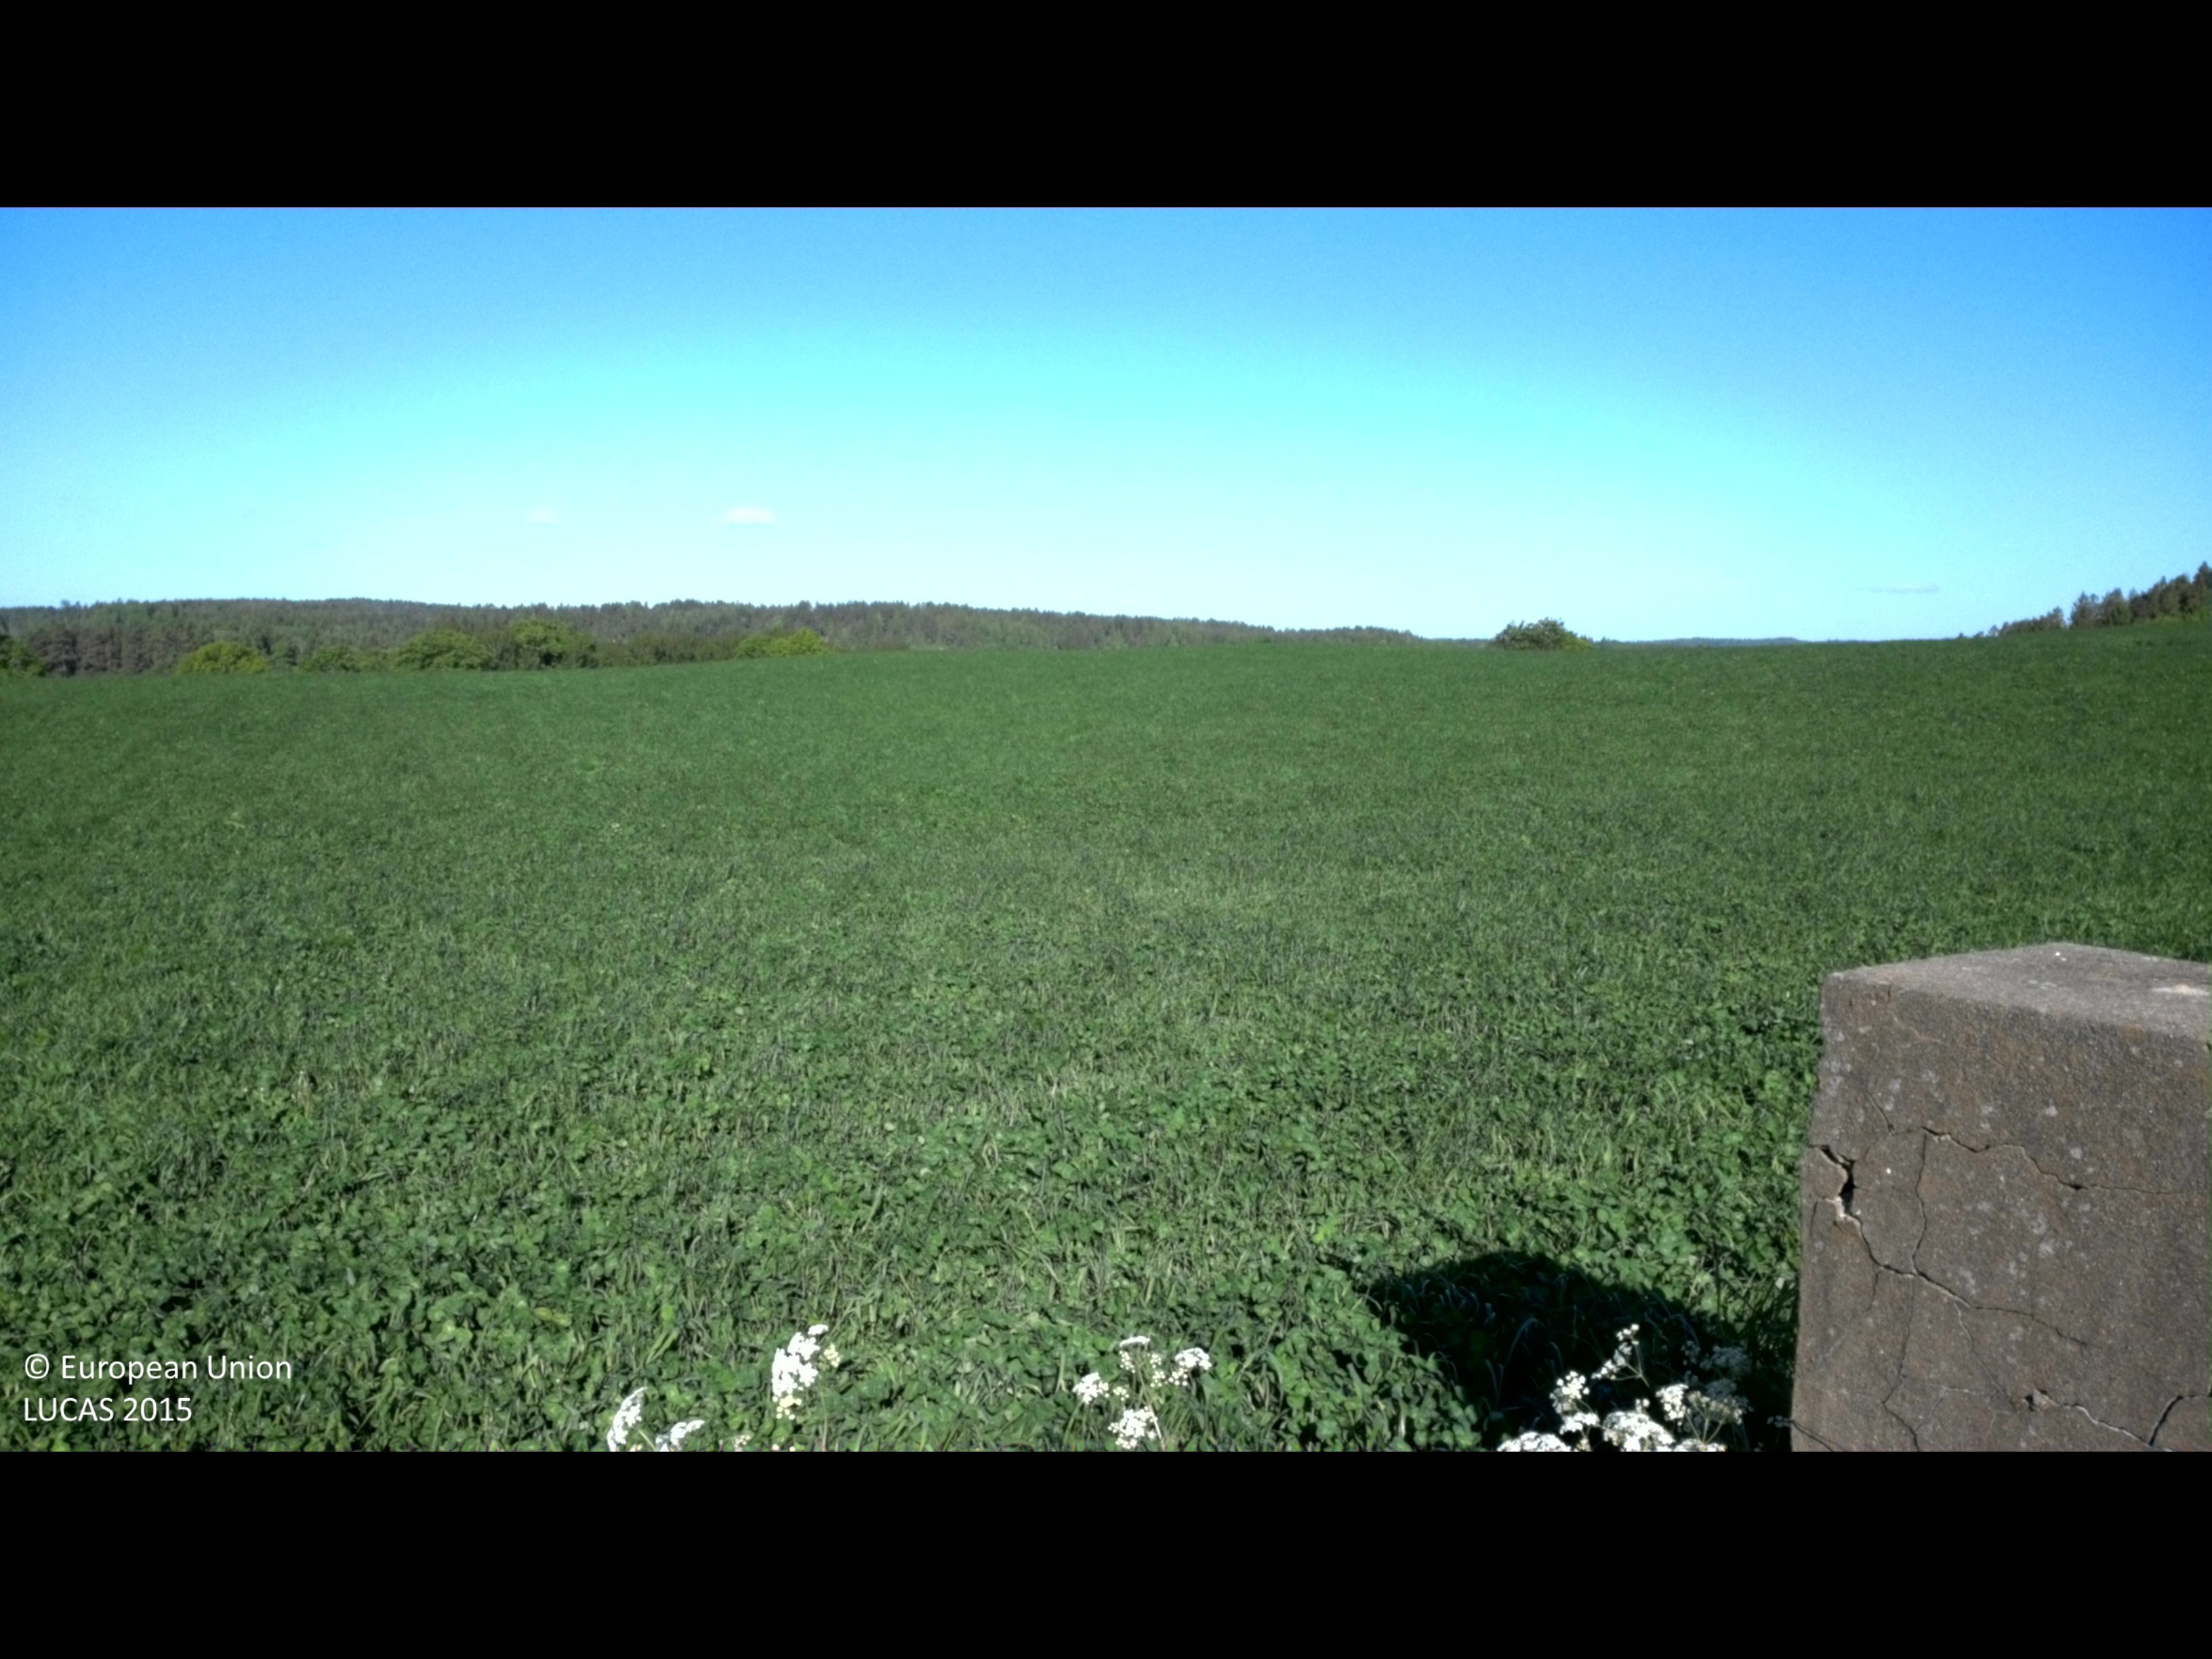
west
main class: Cropland
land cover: Other leguminous and mixtures for fodder
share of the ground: > 75 %
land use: Agriculture (excluding fallow land and kitchen gardens)
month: June
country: SE
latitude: 57.8023
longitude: 16.2740
